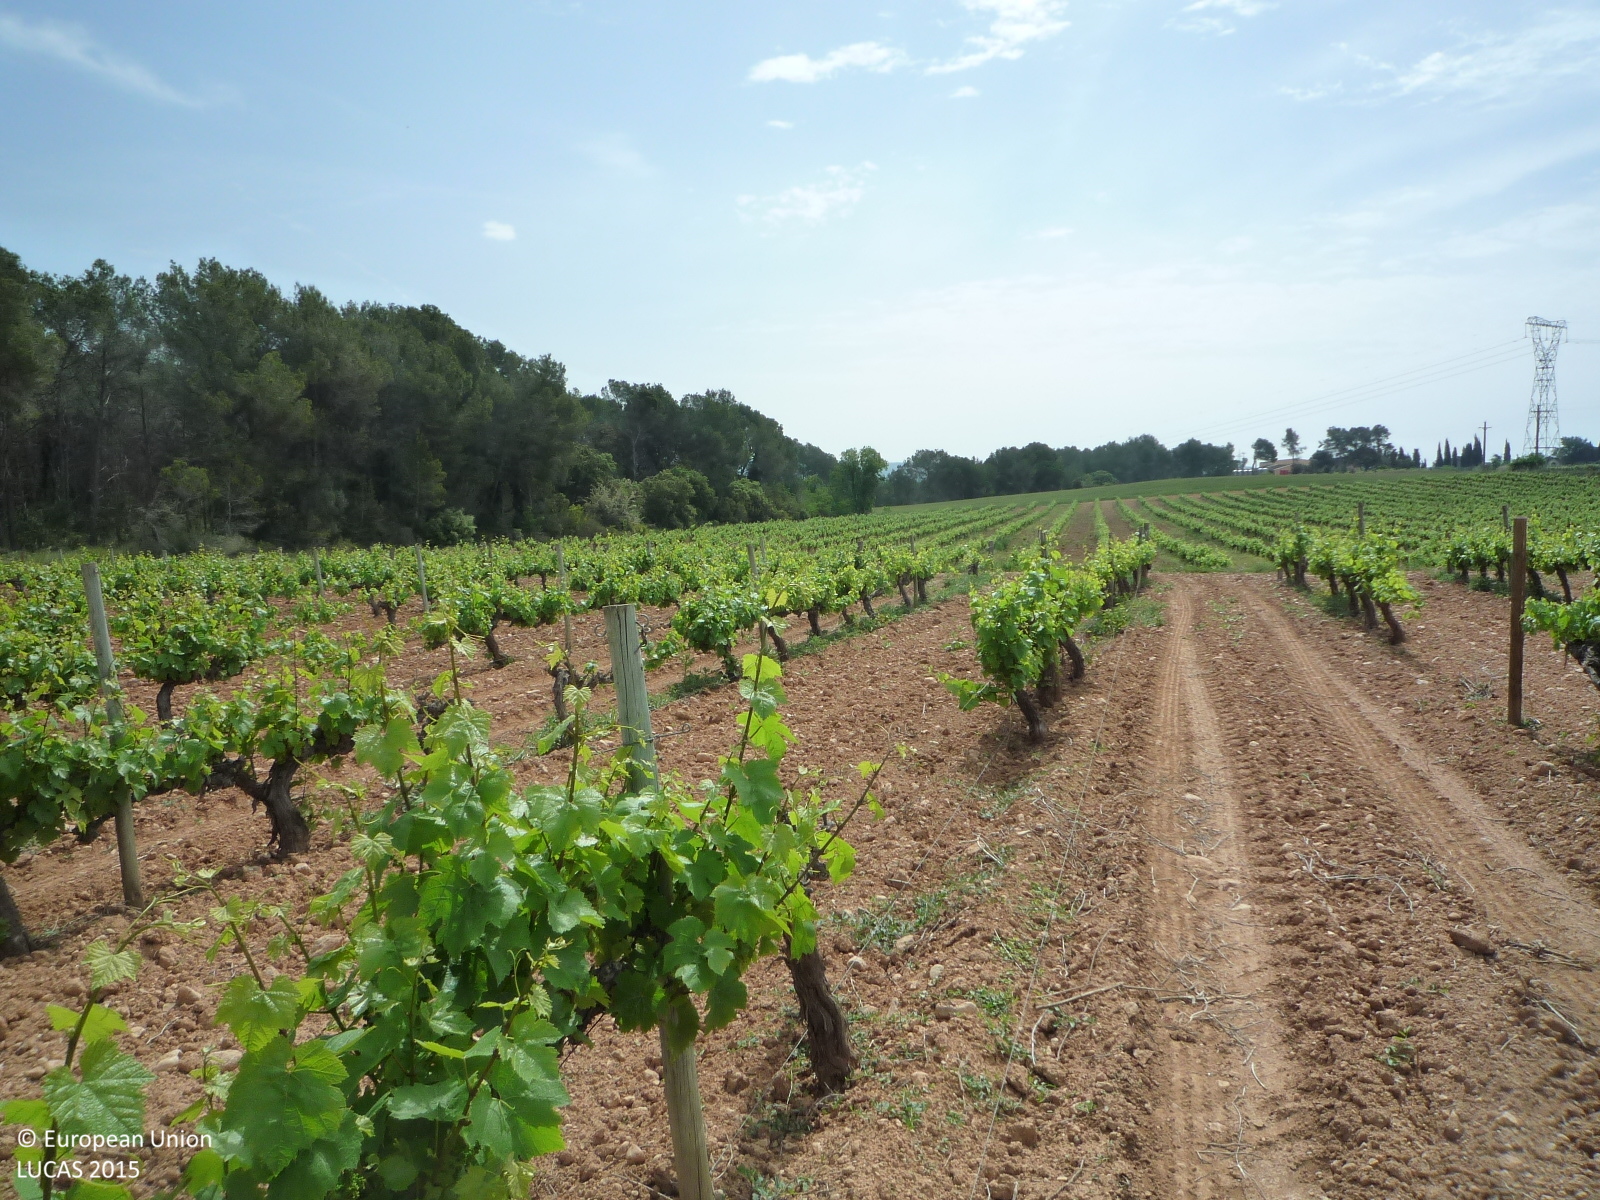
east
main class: Cropland
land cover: Vineyards
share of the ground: 10 - 25 %
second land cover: Other bare soil
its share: > 75 %
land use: Agriculture (excluding fallow land and kitchen gardens)
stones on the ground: 10 - 25 %
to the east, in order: Vineyards; Other bare soil; Tracks; Grass margins; Vineyards; Pine dominated coniferous woodland; Tracks; Pine dominated coniferous woodland
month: May
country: ES
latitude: 41.2878
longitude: 1.5994
